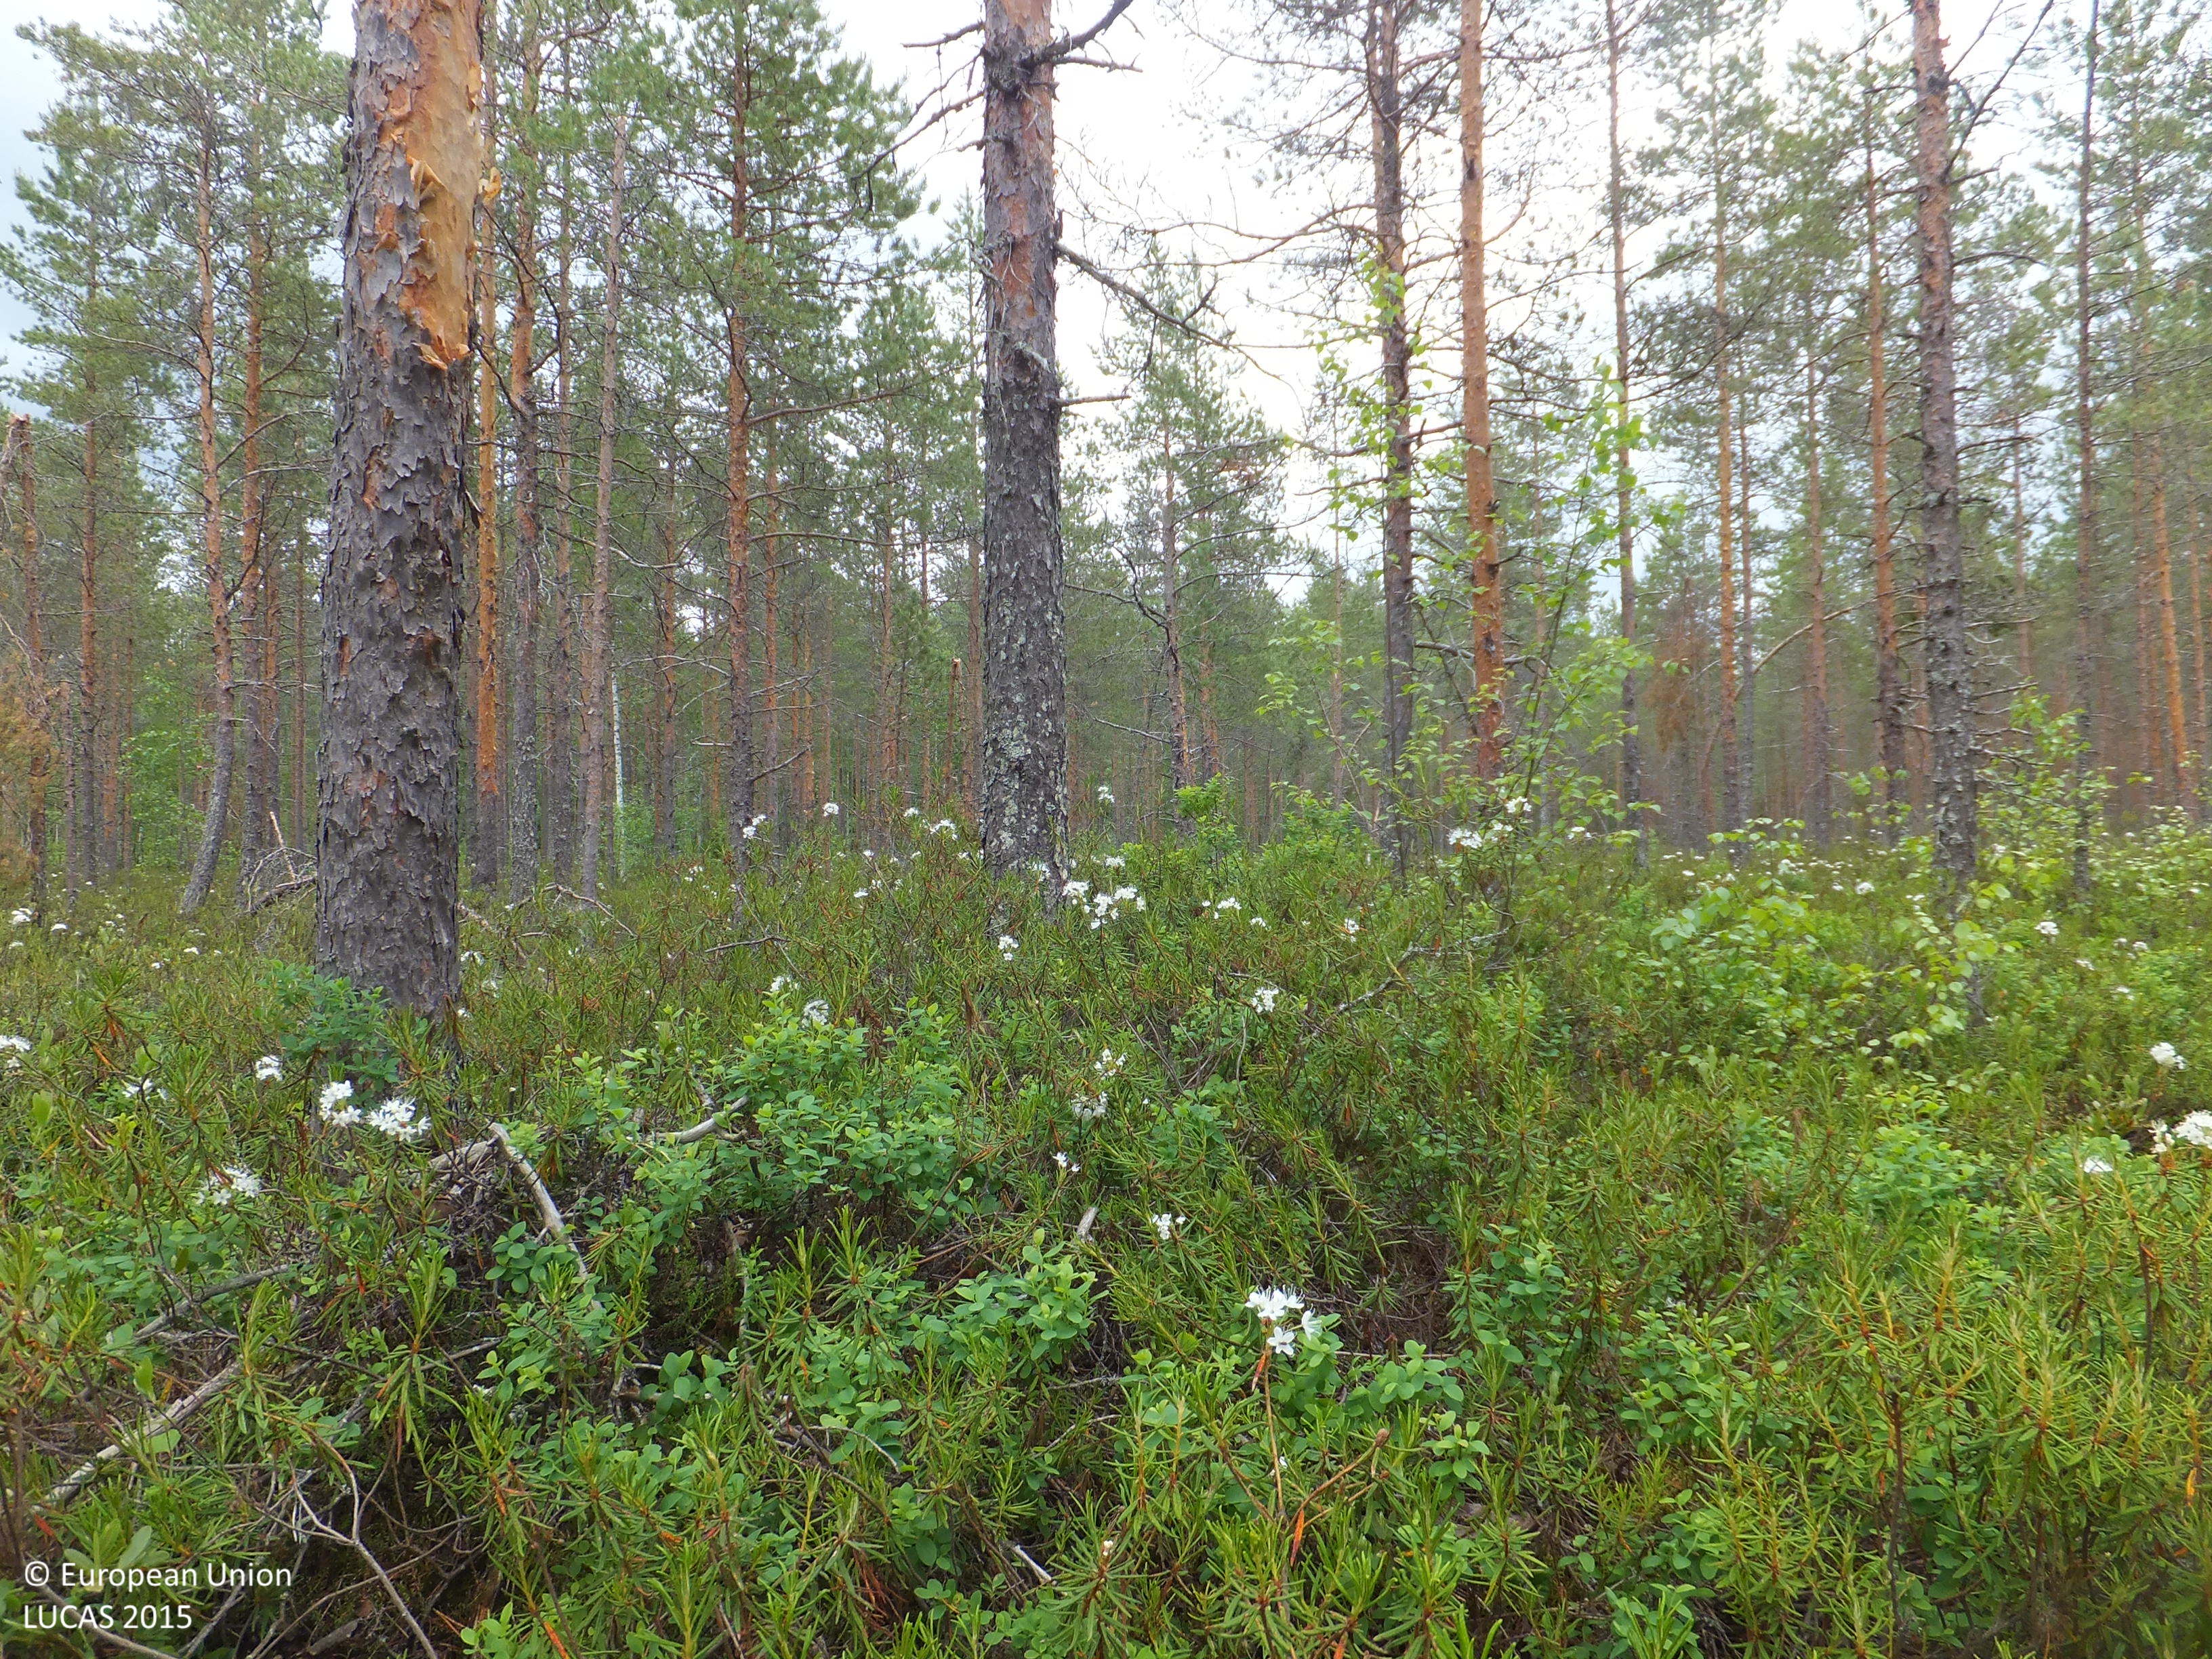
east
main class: Woodland
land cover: Pine dominated mixed woodland
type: boreal forest
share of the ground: 50 - 75 %
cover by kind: coniferous forest trees 40 %, shrubs 30 %, broadleaved forest trees 25 %, lichens and mosses 5 %
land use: Forestry
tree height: > 5 m
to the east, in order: Pine dominated mixed woodland; Ditches and canals; Pine dominated mixed woodland; Ditches and canals; Broadleaved woodland; Ditches and canals; Broadleaved woodland; Ditches and canals; Other mixed woodland; Pine dominated mixed woodland
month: June
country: FI
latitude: 63.5193
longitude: 24.1644
